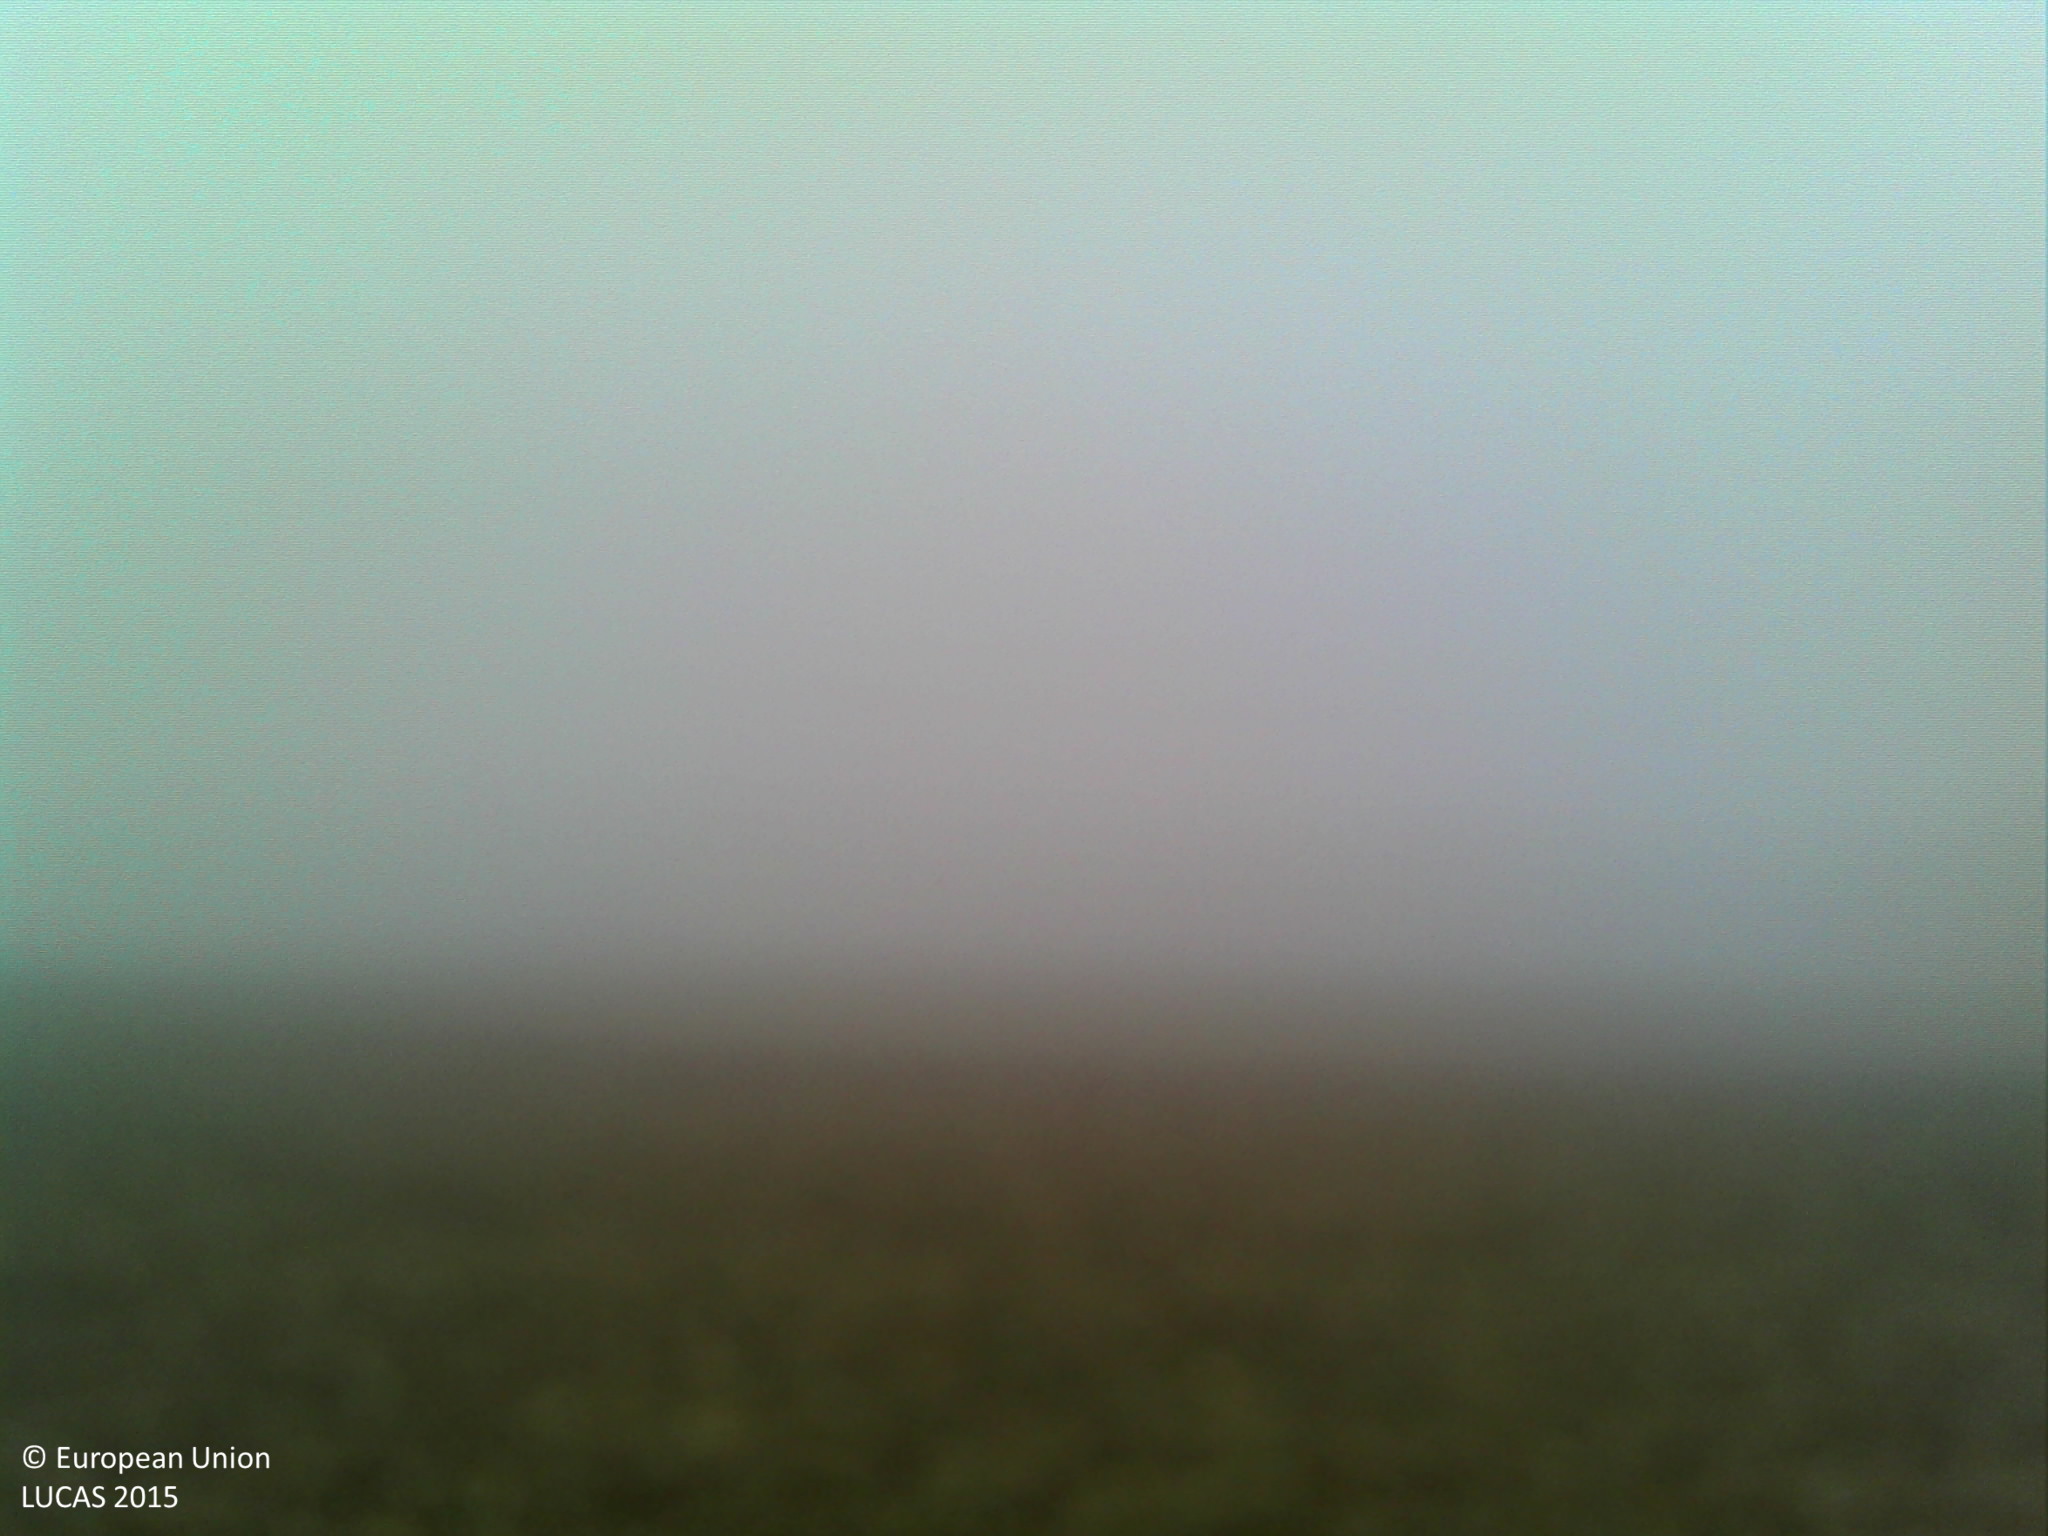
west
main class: Cropland
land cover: Maize
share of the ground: > 75 %
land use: Agriculture (excluding fallow land and kitchen gardens)
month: December
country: FR
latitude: 46.0140
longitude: 5.3151
